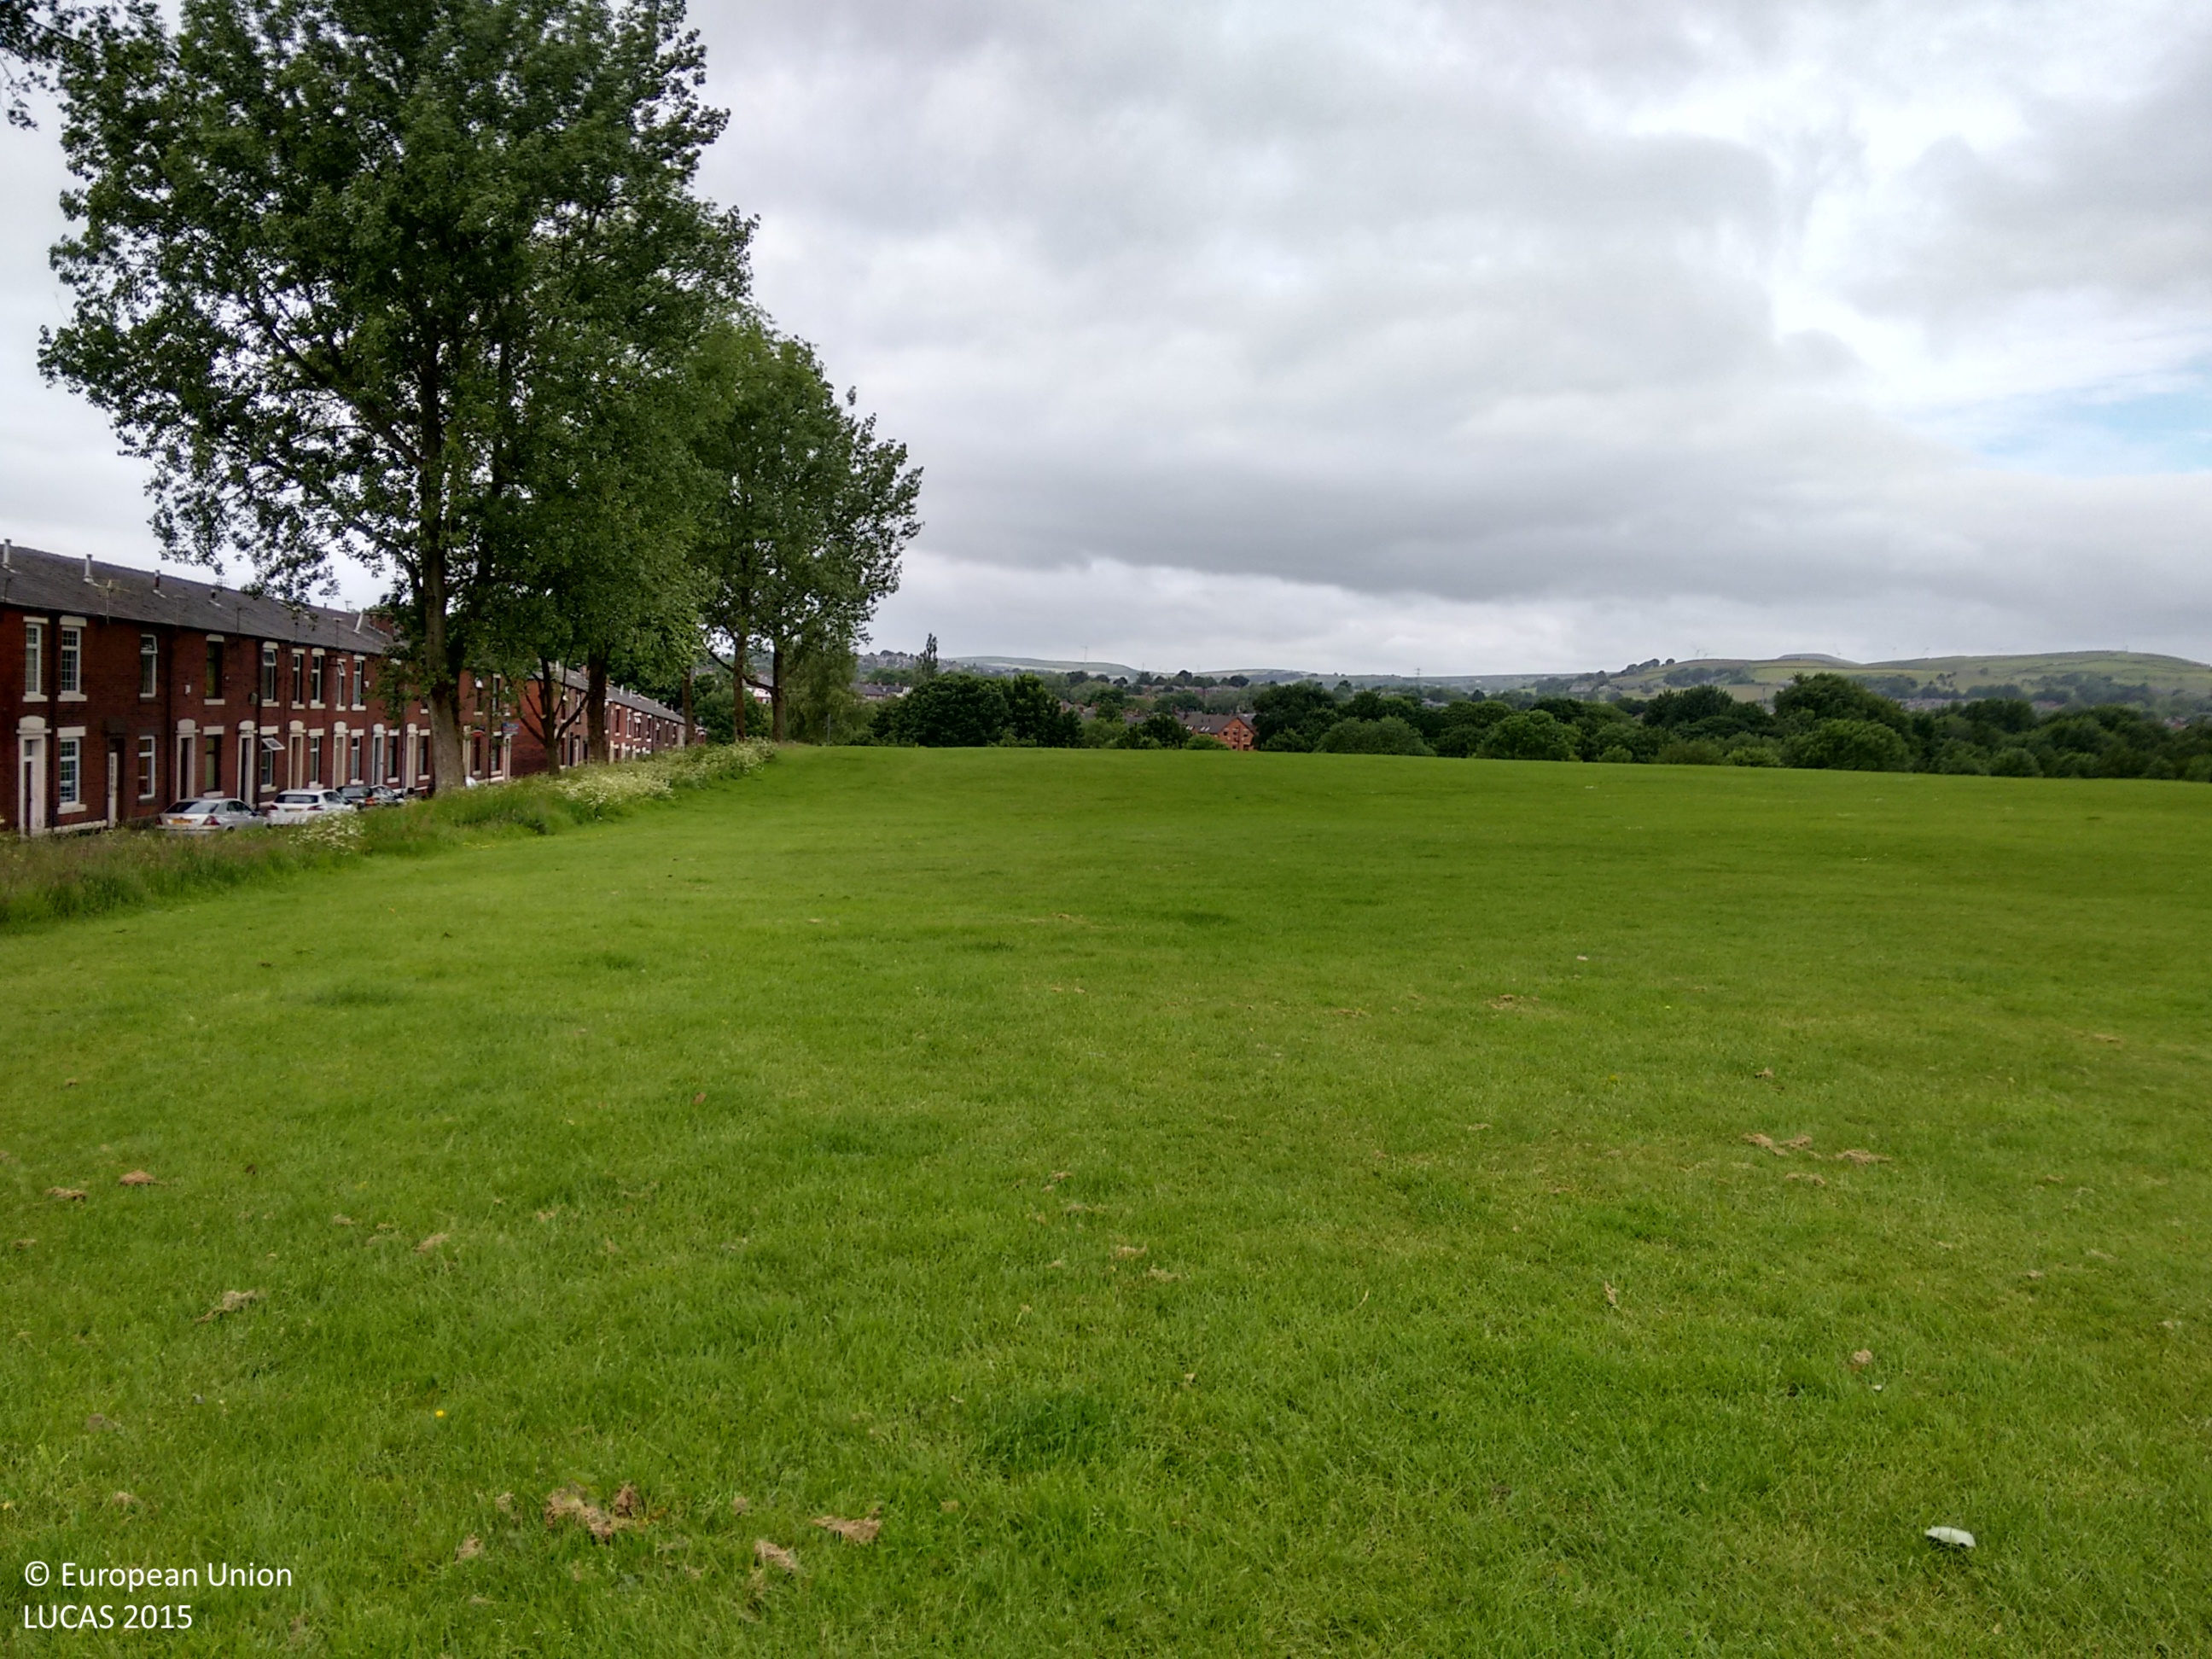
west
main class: Grassland
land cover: Grassland without tree/shrub cover
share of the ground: > 75 %
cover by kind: herbaceous plants 100 %
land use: Sport
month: June
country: GB
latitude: 53.6221
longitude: -2.1702
